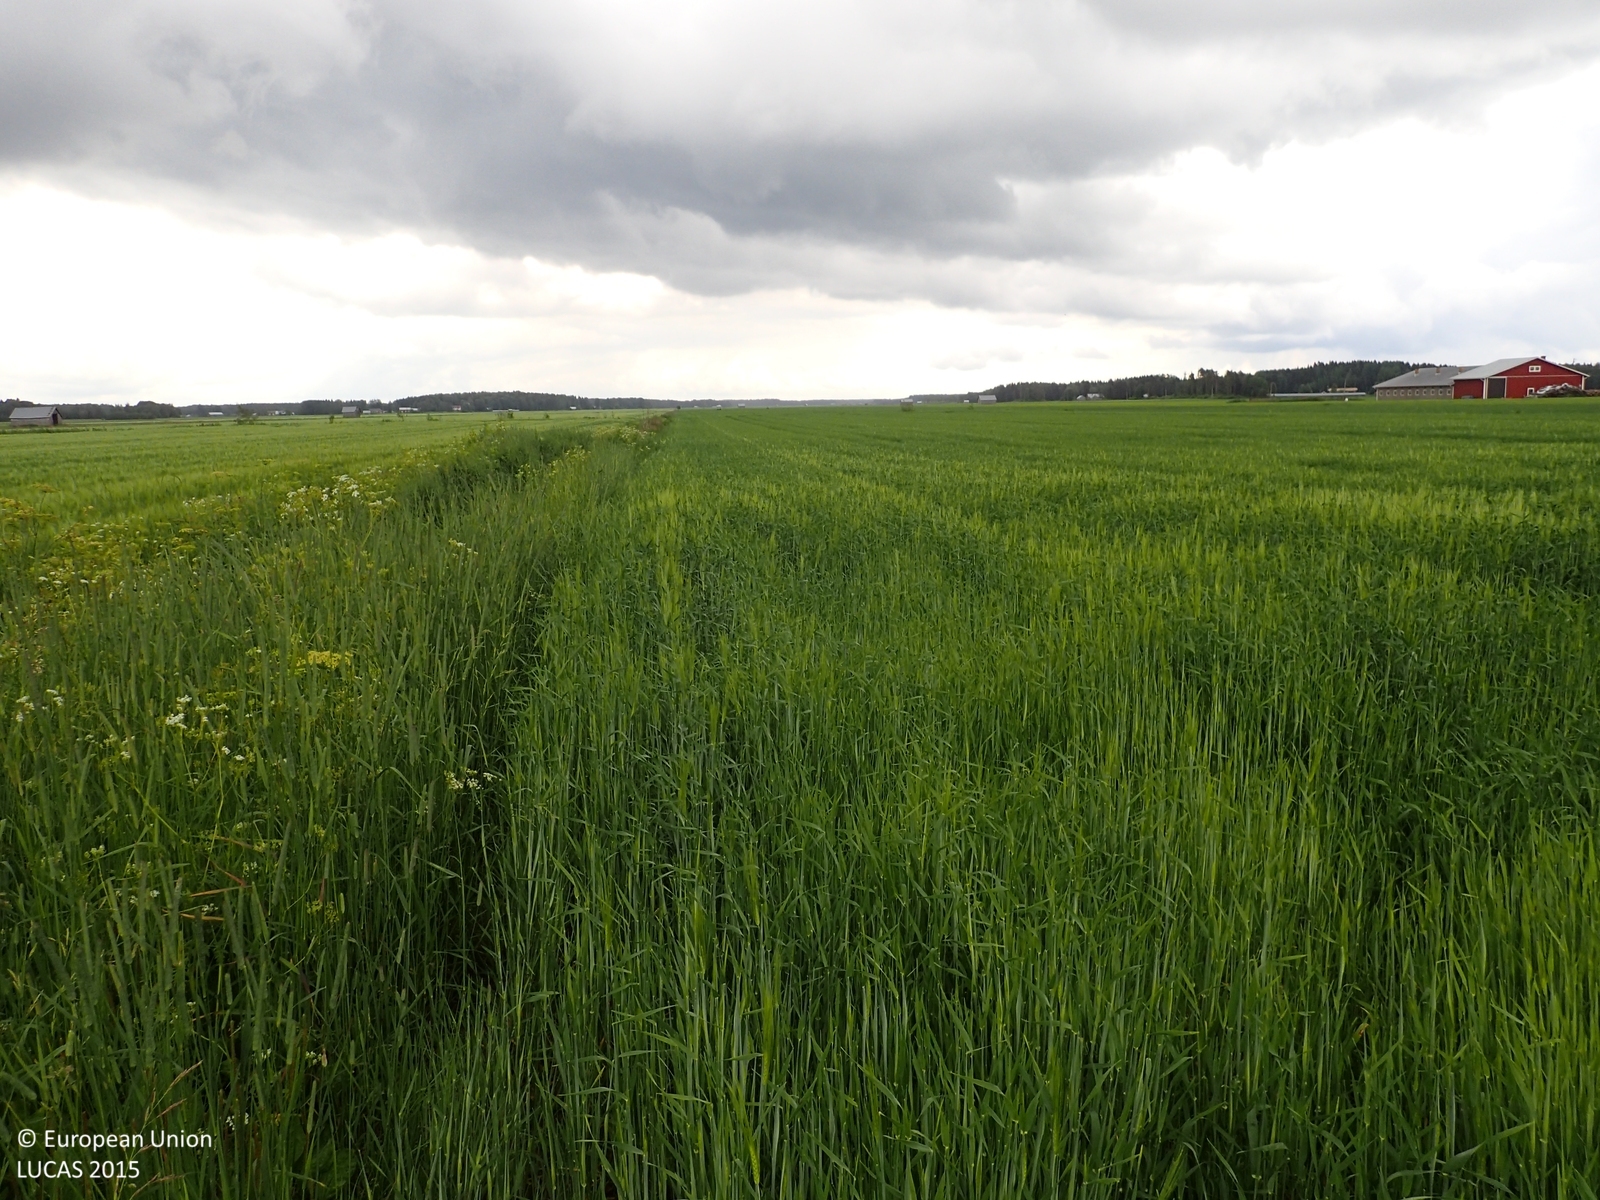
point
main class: Cropland
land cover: Arable land (only in case pi)
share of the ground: > 75 %
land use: Agriculture (excluding fallow land and kitchen gardens)
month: July
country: FI
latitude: 62.9234
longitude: 21.6801
